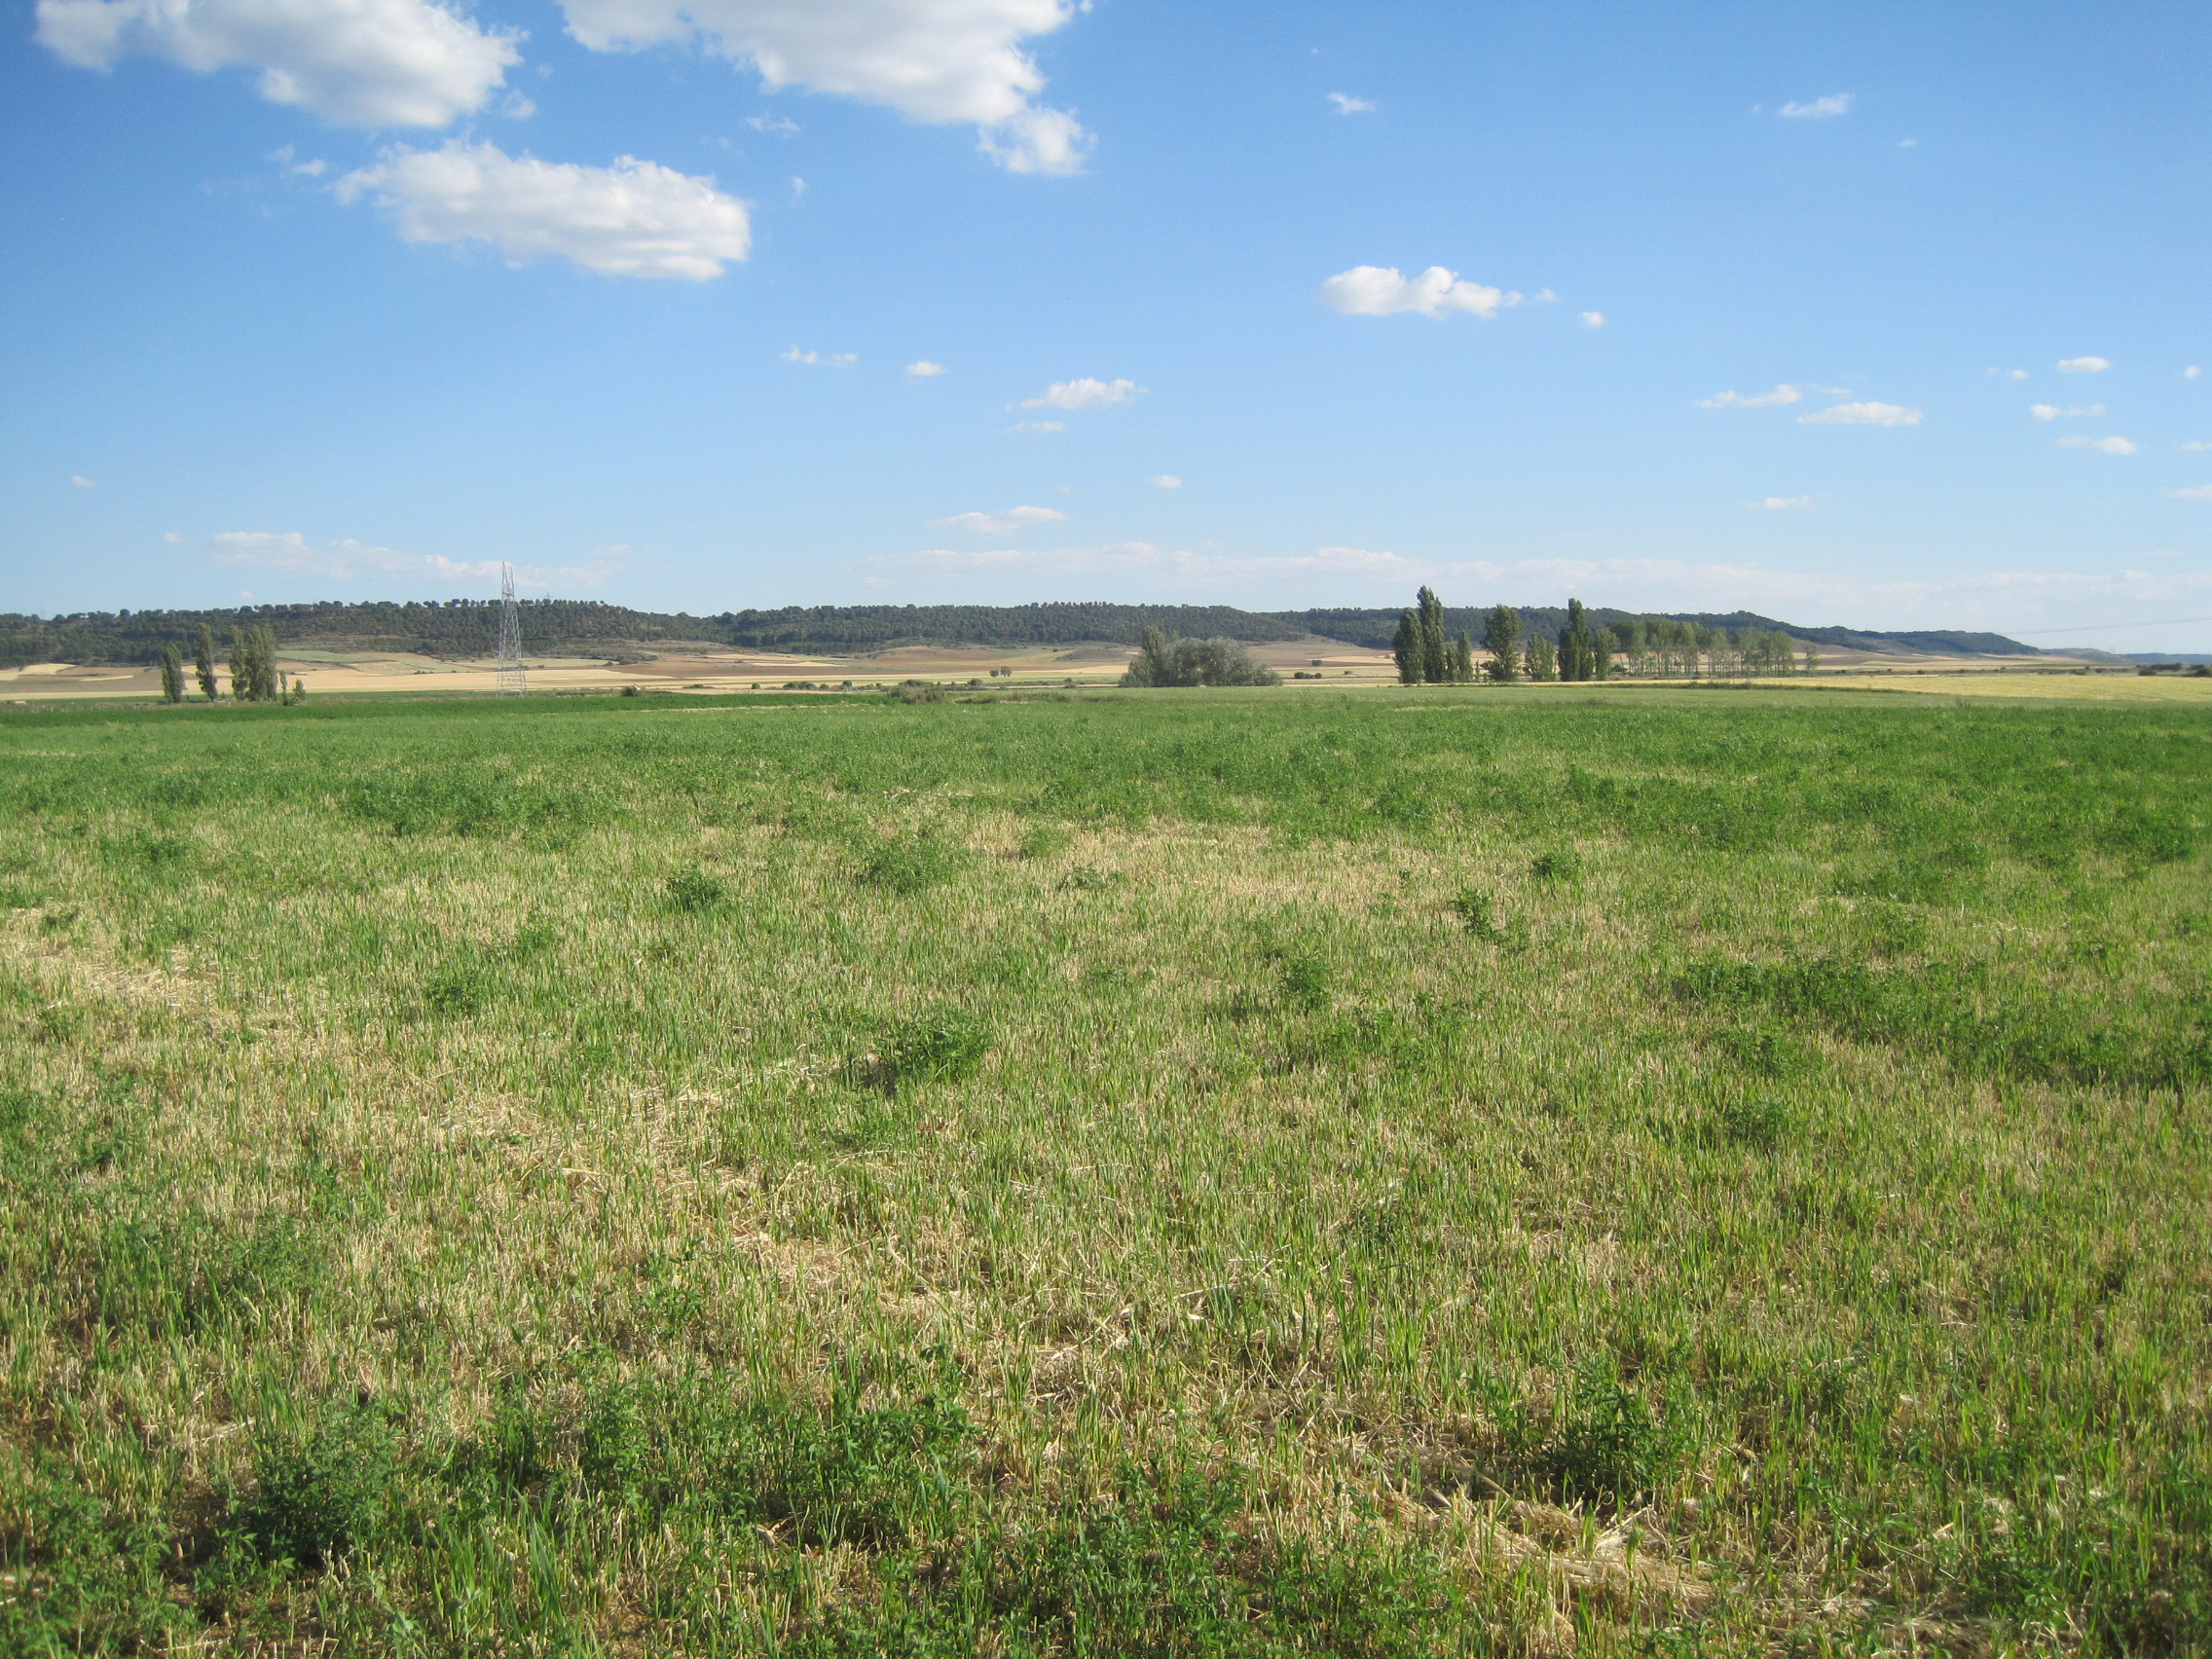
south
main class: Cropland
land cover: Mixed cereals for fodder
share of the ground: > 75 %
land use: Agriculture (excluding fallow land and kitchen gardens)
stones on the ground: 10 - 25 %
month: June
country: ES
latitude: 41.7990
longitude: -5.1587
